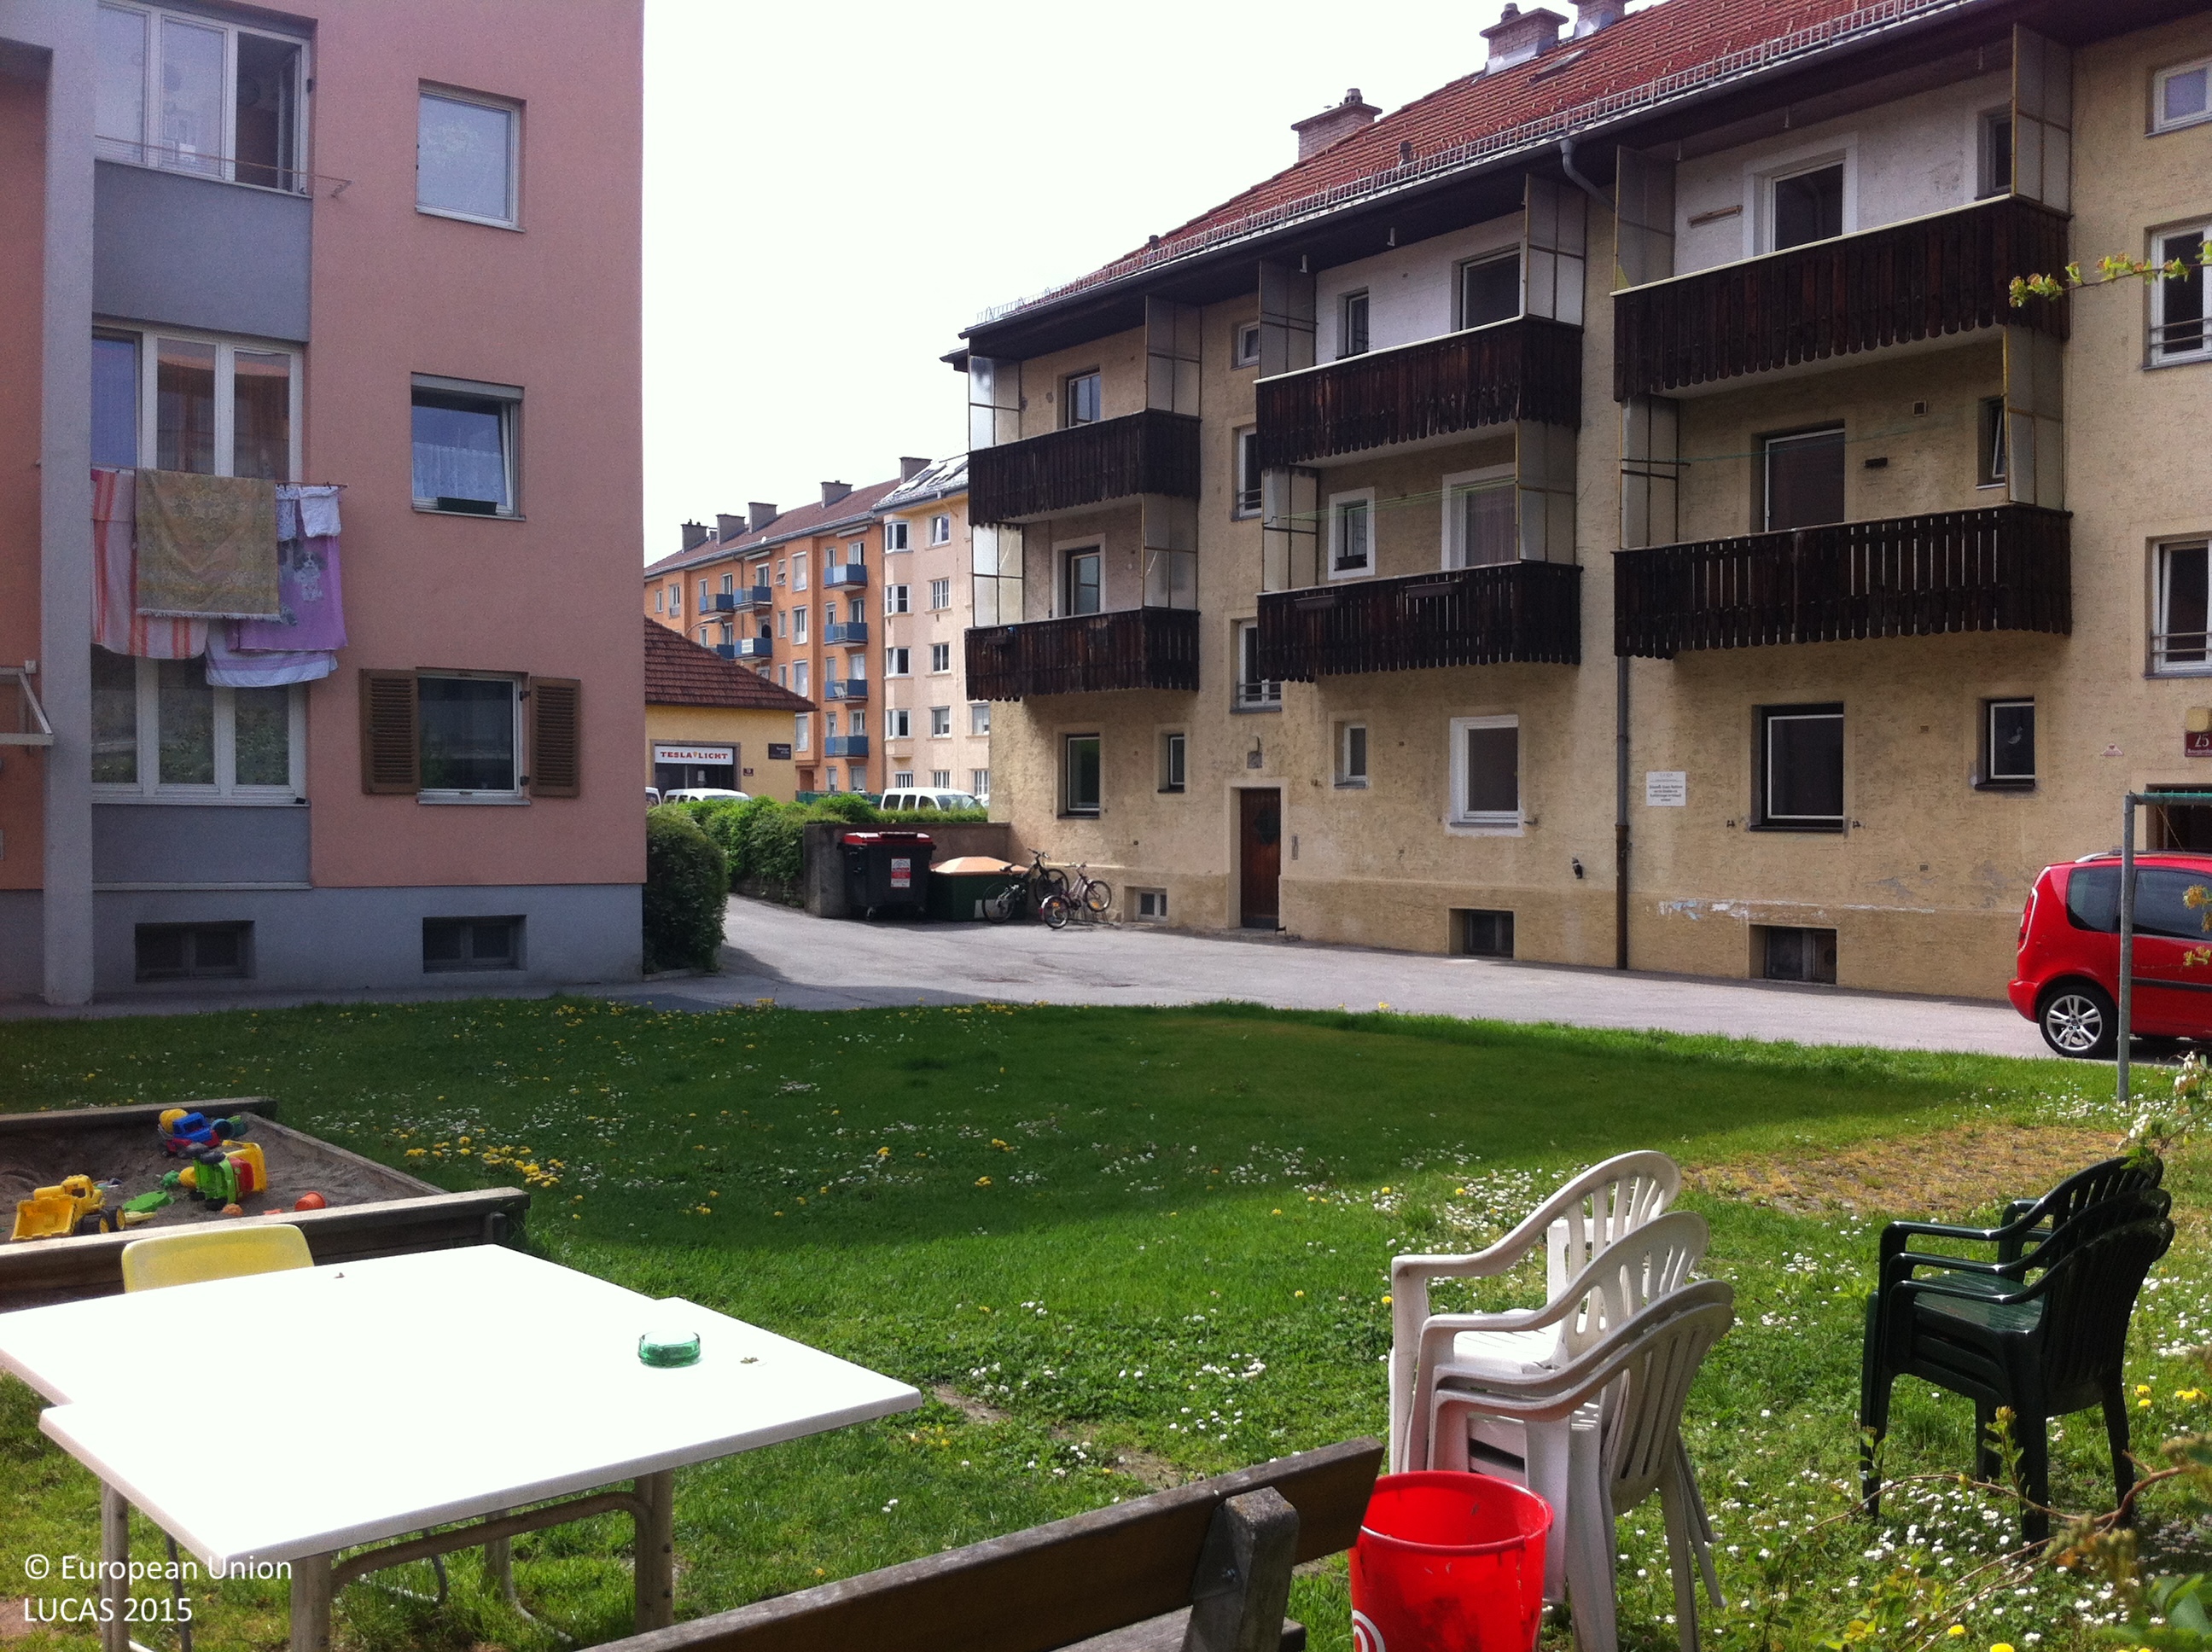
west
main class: Grassland
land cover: Grassland without tree/shrub cover
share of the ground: > 75 %
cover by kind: herbaceous plants 100 %
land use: Residential
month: May
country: AT
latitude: 47.2604
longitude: 11.4128
